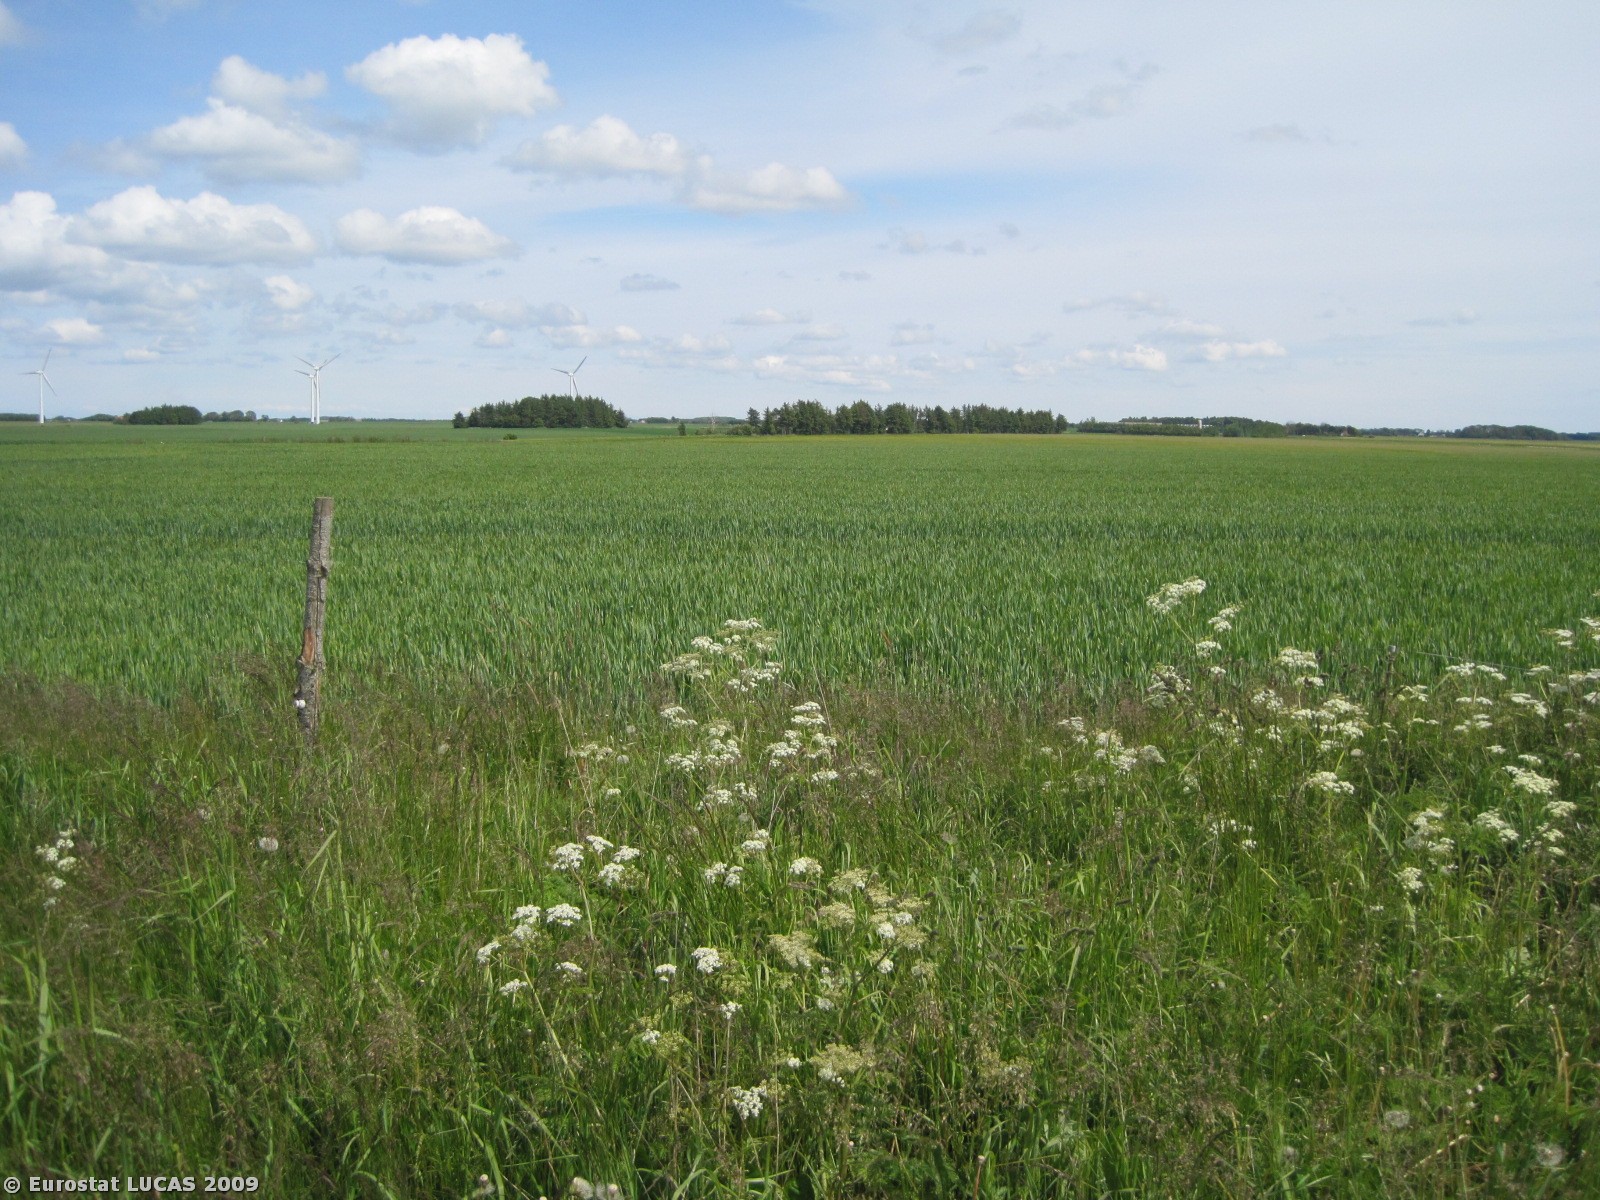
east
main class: Grassland
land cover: Grassland without tree/shrub cover
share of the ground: > 75 %
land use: Unused
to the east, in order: Grassland without tree/shrub cover; Fences; Common wheat
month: June
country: DK
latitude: 57.3742
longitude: 9.8838
